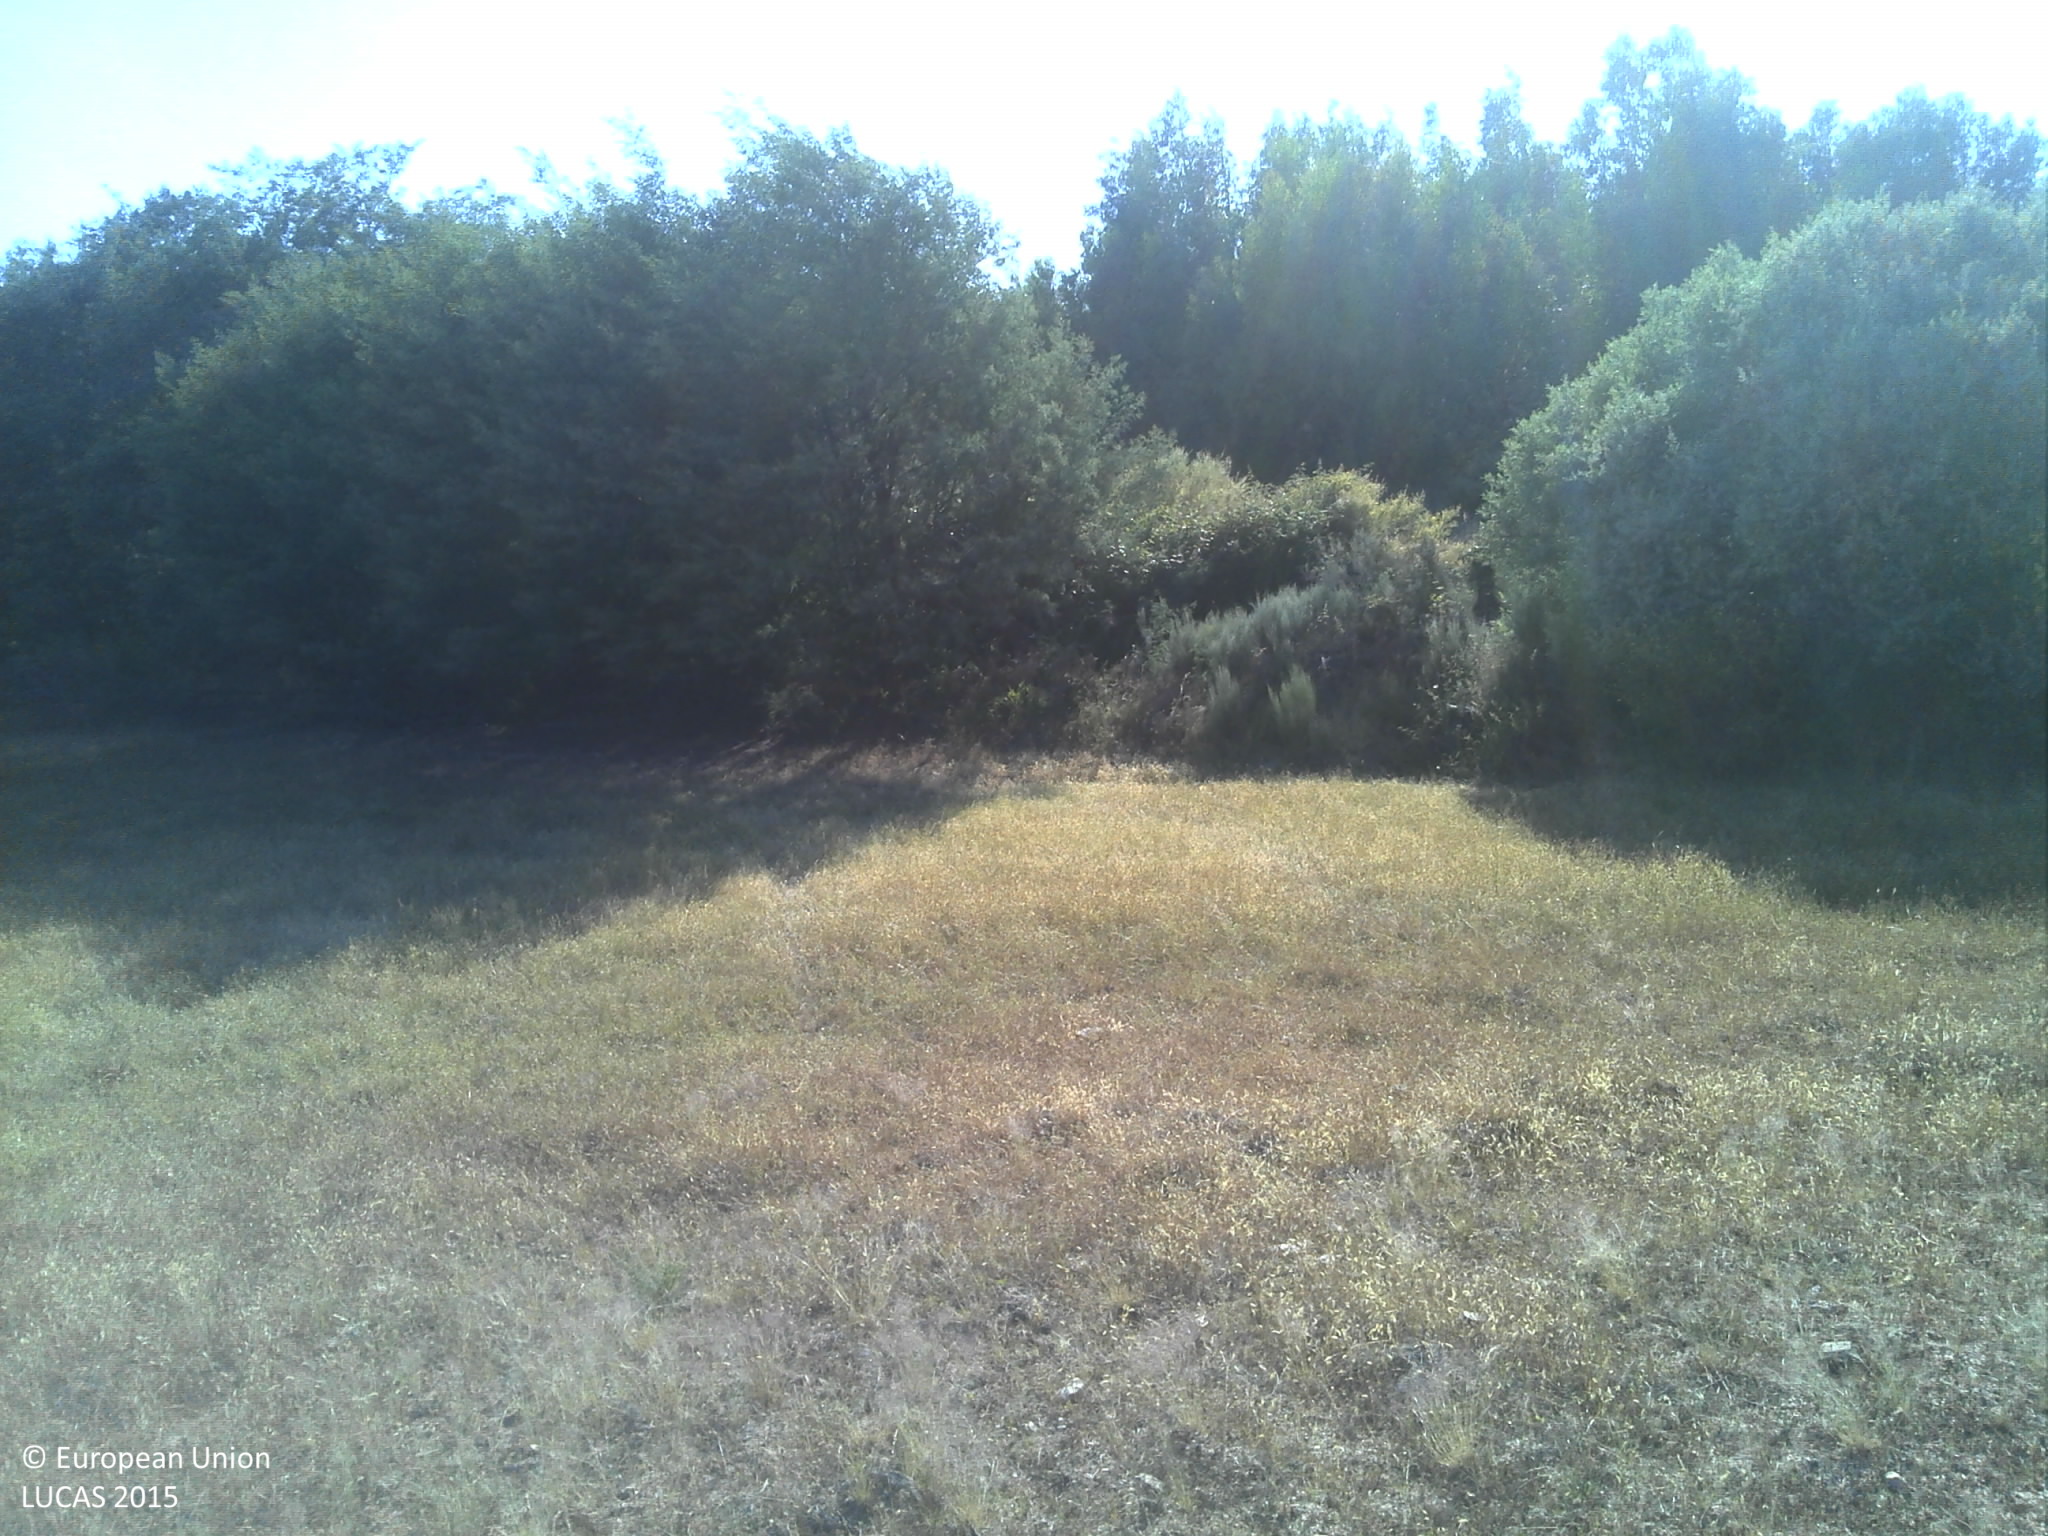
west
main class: Grassland
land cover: Spontaneously vegetated surfaces
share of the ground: 10 - 25 %
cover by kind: unconsolidated bare surface 70 %, herbaceous plants 25 %
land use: Agriculture (excluding fallow land and kitchen gardens)
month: June
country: PT
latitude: 40.0046
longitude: -7.4257
